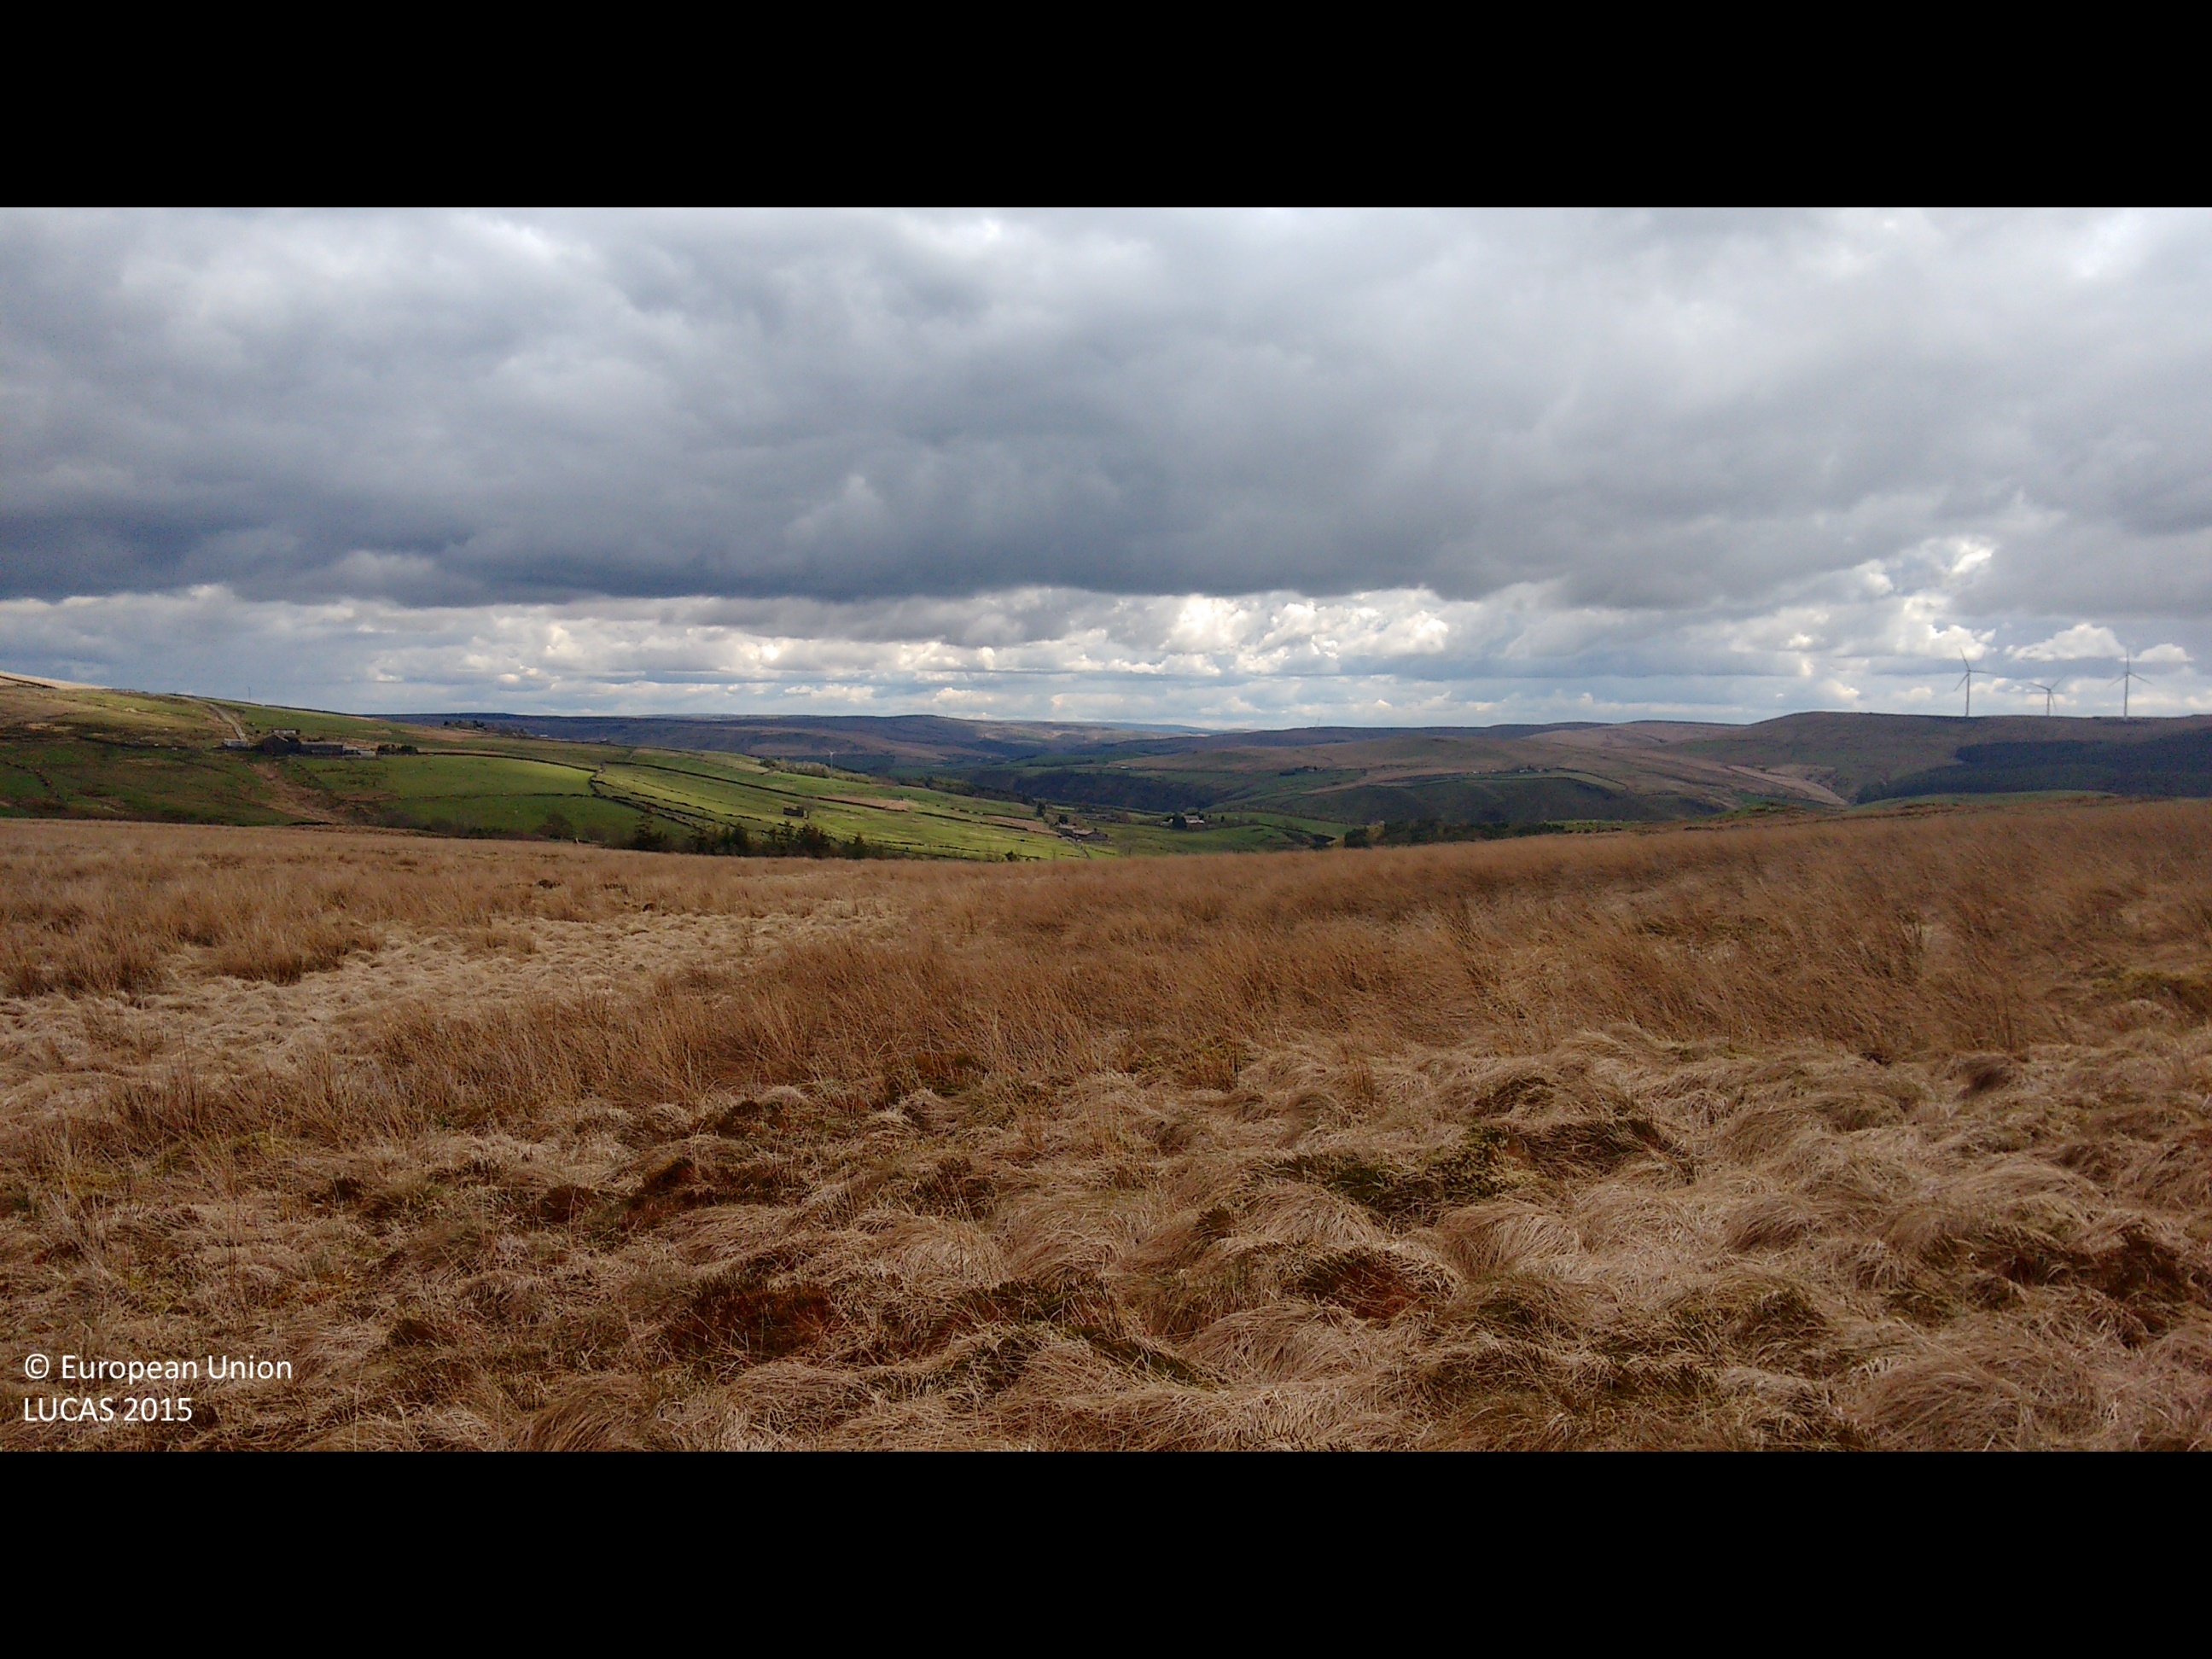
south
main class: Grassland
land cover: Grassland without tree/shrub cover
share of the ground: > 75 %
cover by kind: herbaceous plants 100 %
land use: Agriculture (excluding fallow land and kitchen gardens)
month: April
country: GB
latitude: 53.7519
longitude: -2.1463
